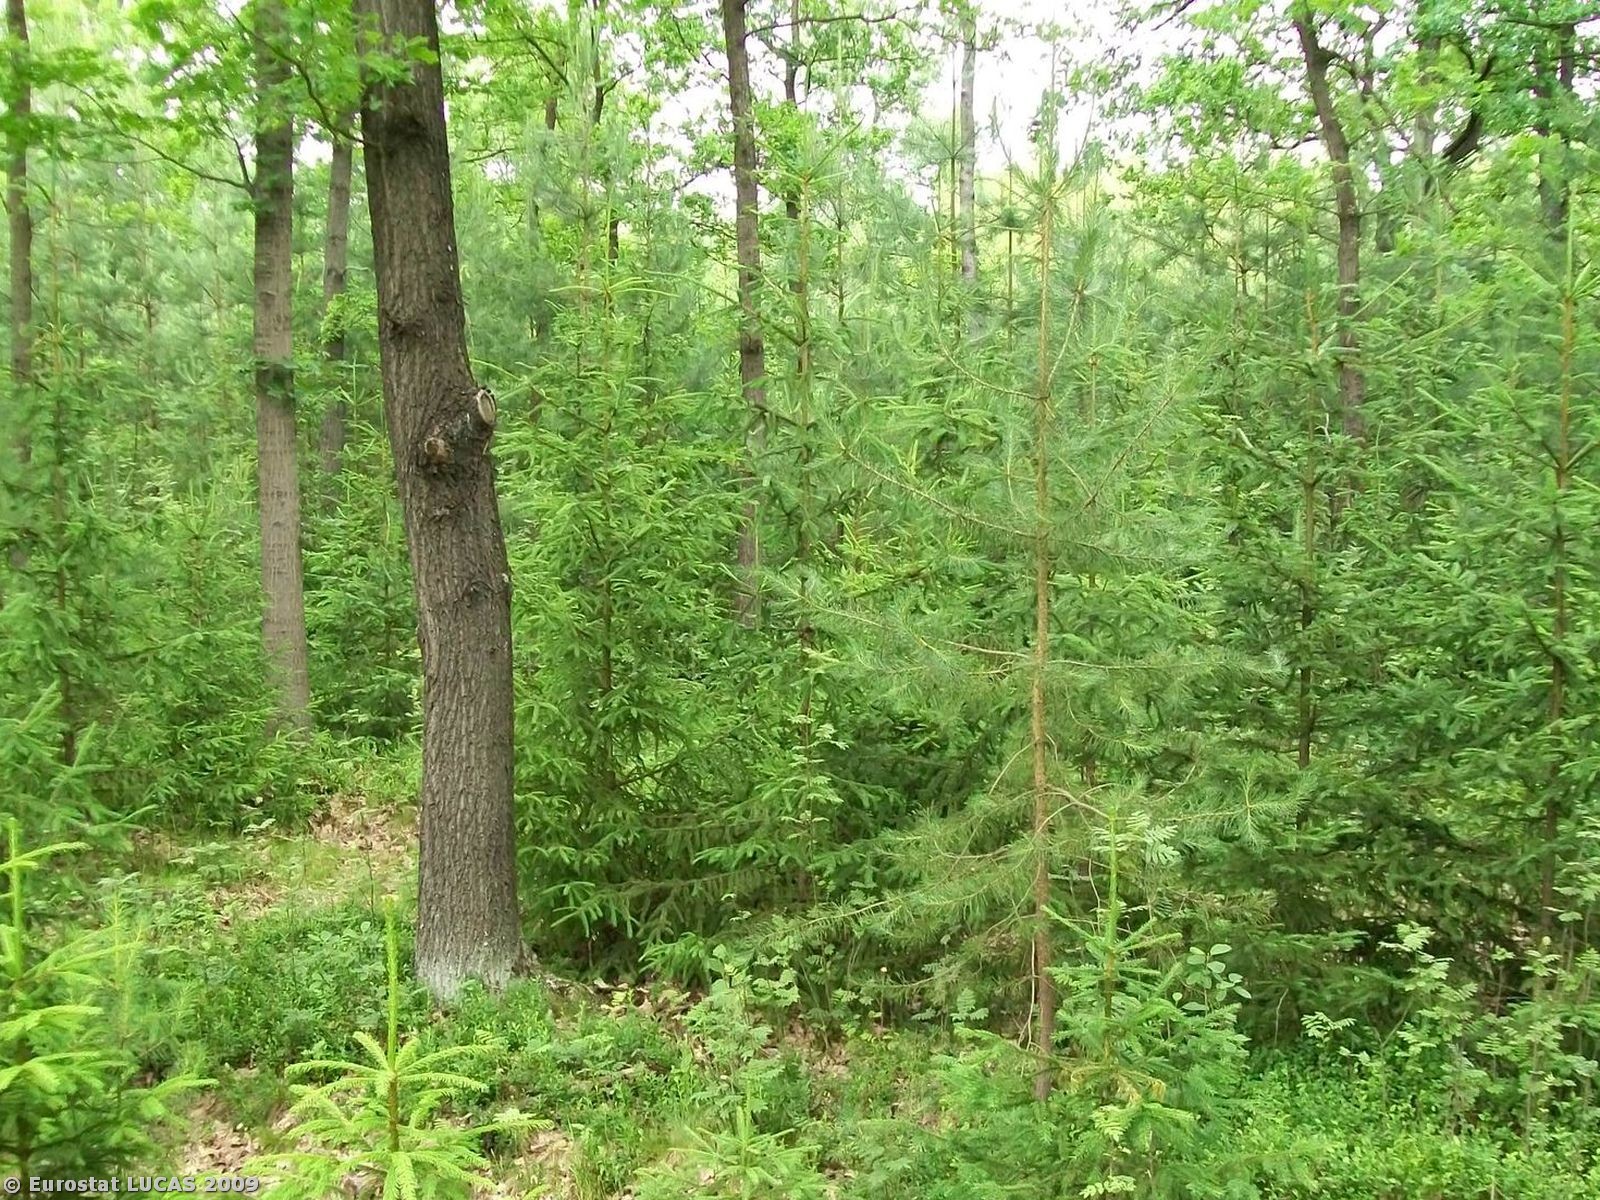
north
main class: Woodland
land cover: Mixed woodland
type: hemiboreal forest and nemoral coniferous forest and mixed broadleaved-coniferous forest
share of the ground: > 75 %
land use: Unused
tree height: > 5 m
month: September
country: PL
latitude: 50.8515
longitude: 17.8700
